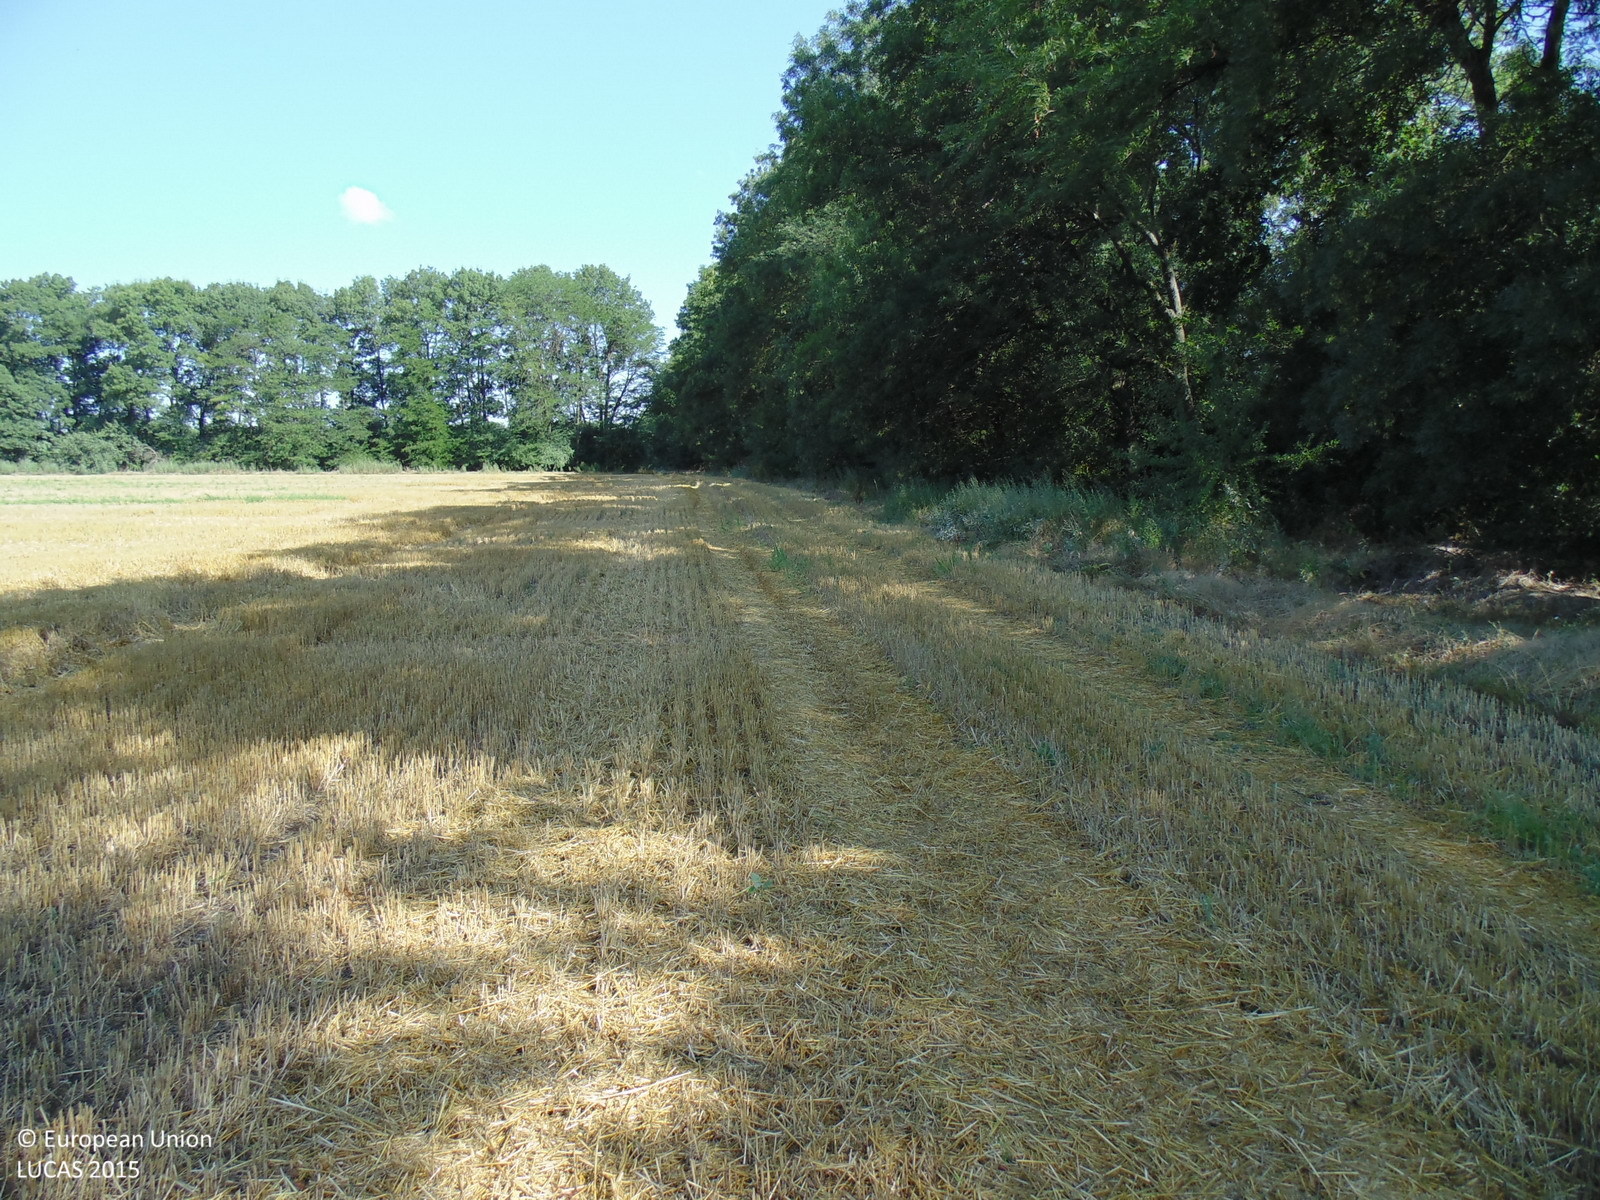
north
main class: Cropland
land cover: Common wheat
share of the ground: 50 - 75 %
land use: Agriculture (excluding fallow land and kitchen gardens)
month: August
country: BG
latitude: 43.6701
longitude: 28.0713
